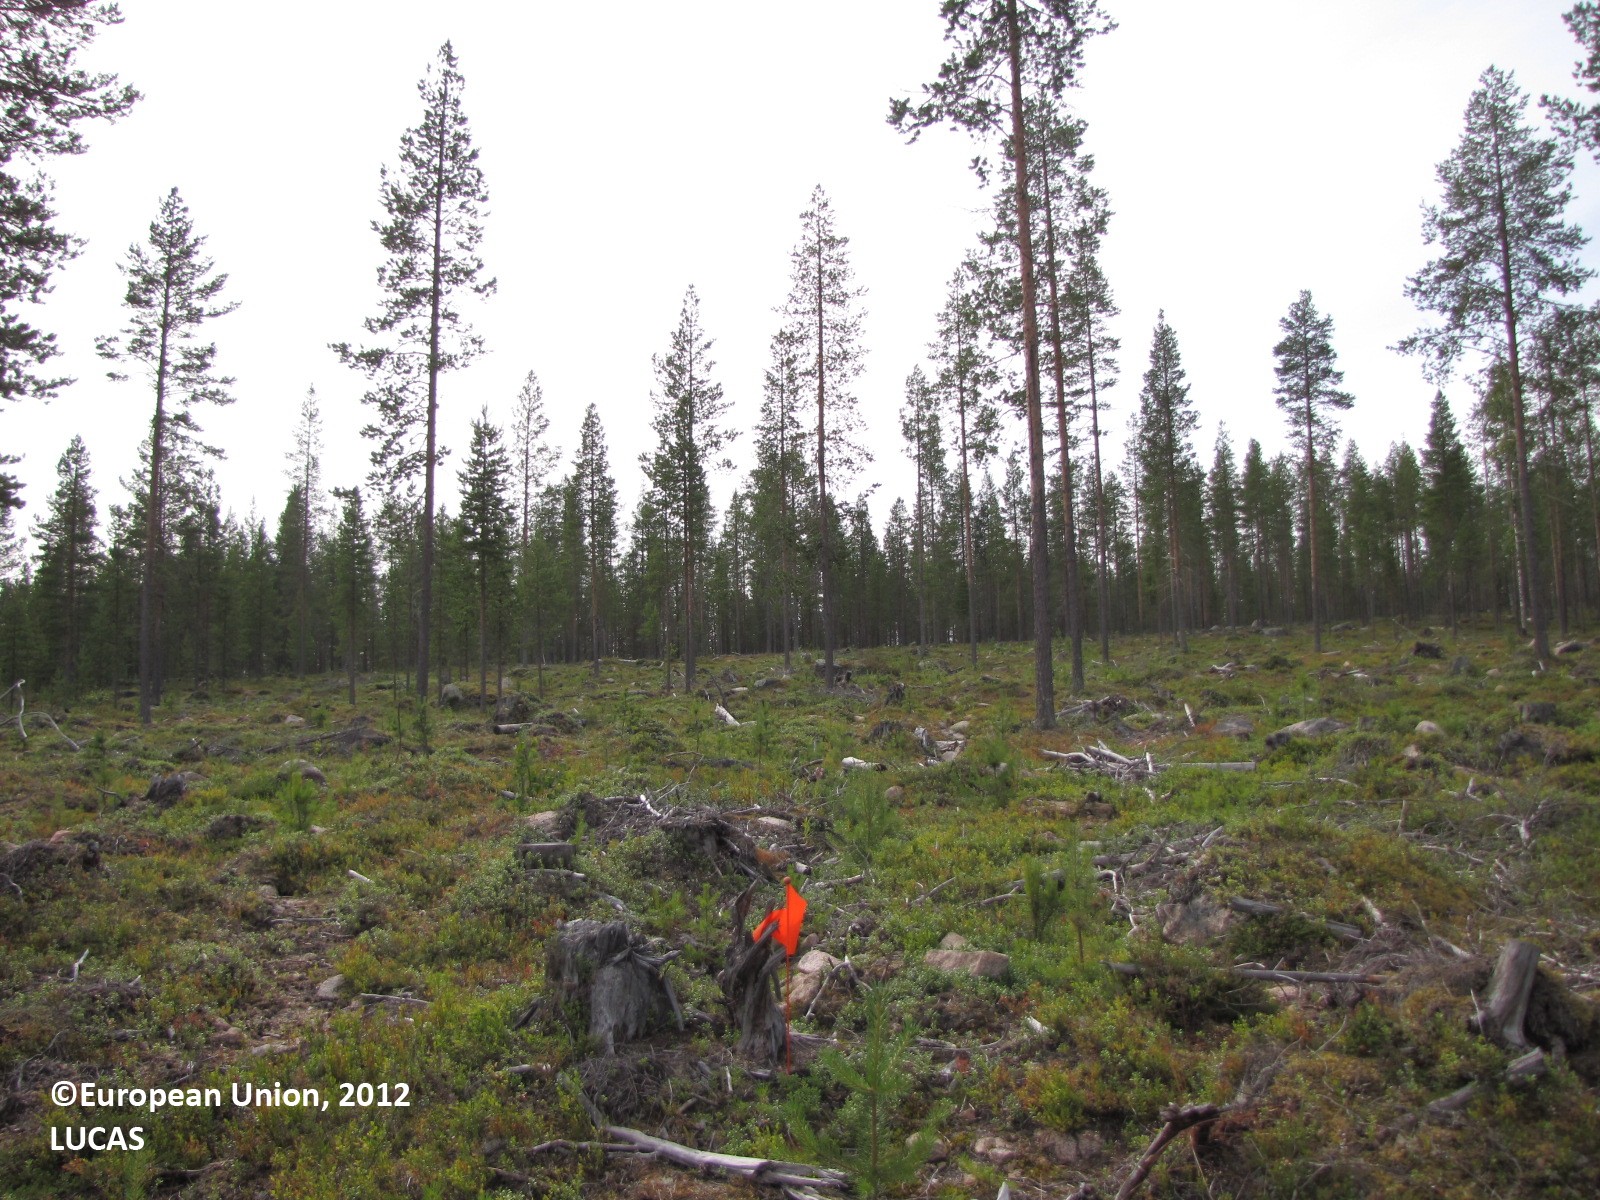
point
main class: Woodland
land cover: Pine dominated coniferous woodland
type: boreal forest
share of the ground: 25 - 50 %
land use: Forestry
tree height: > 5 m
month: August
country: FI
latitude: 66.8997
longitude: 24.9624
